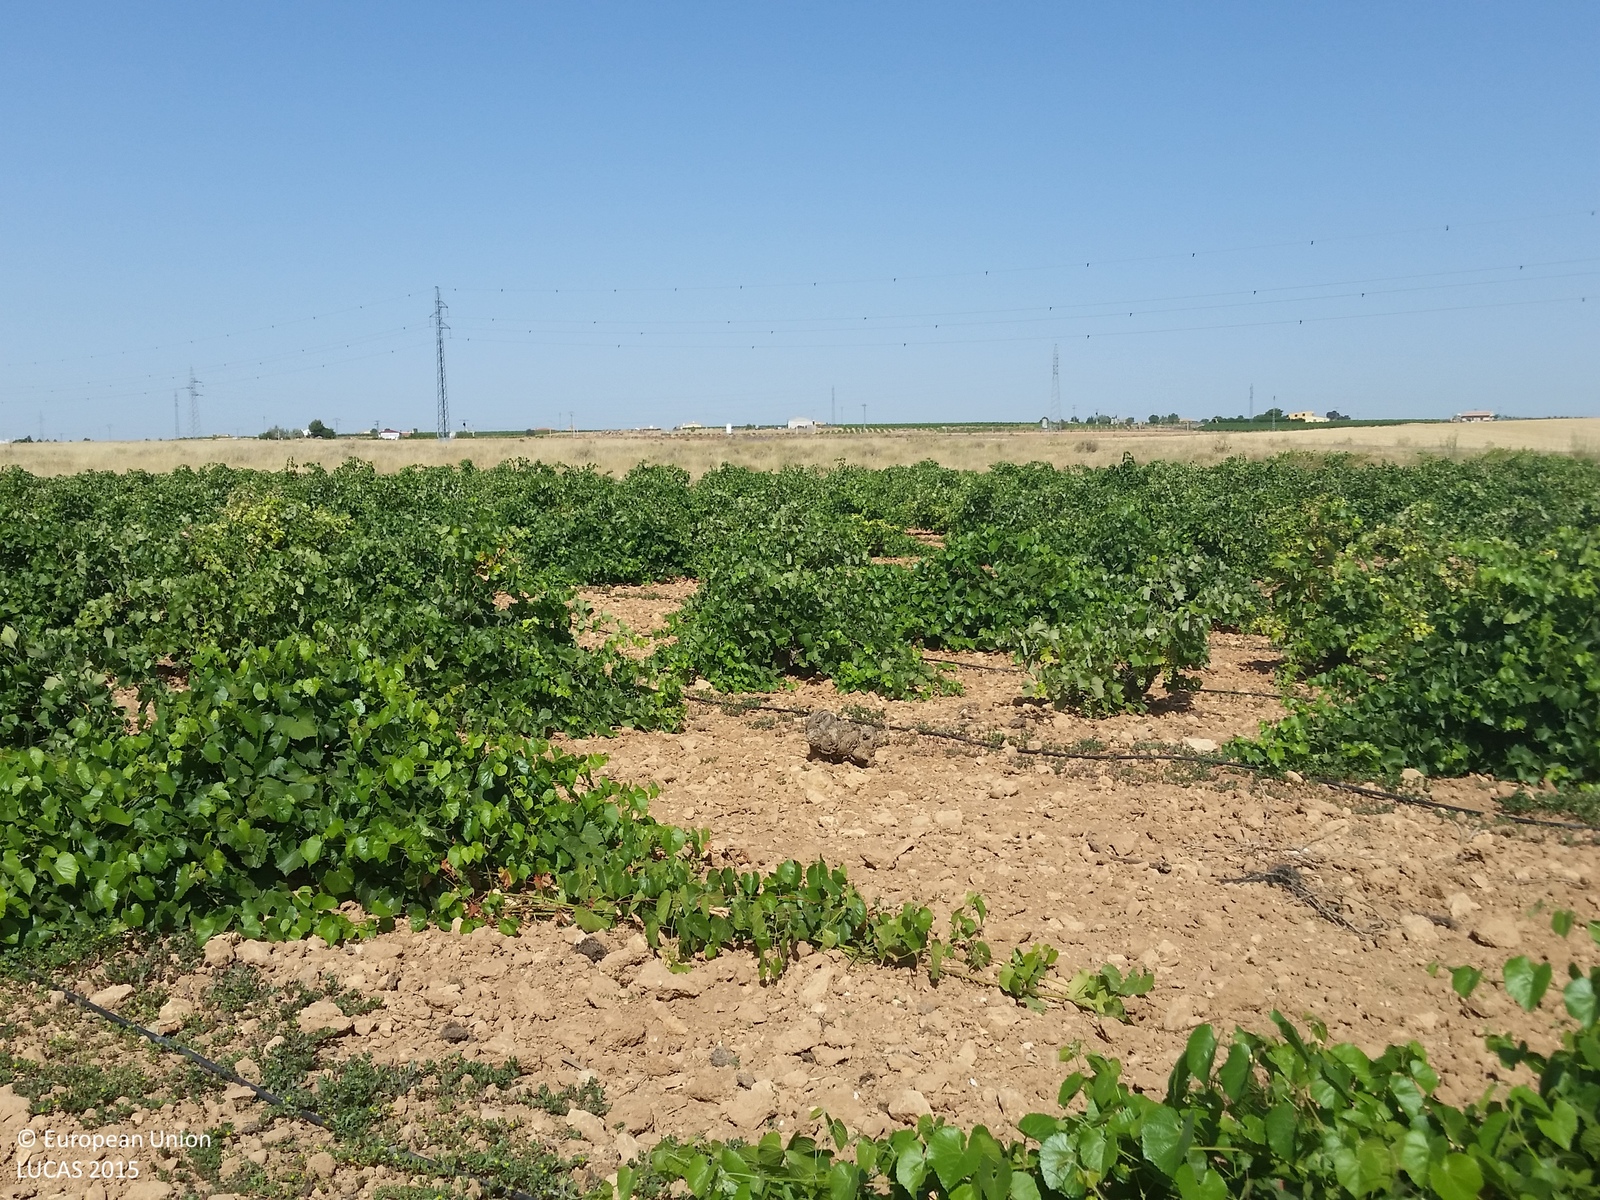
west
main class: Cropland
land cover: Vineyards
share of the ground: 50 - 75 %
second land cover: Other bare soil
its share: > 75 %
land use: Agriculture (excluding fallow land and kitchen gardens)
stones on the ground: 10 - 25 %
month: July
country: ES
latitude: 39.2882
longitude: -2.5896
